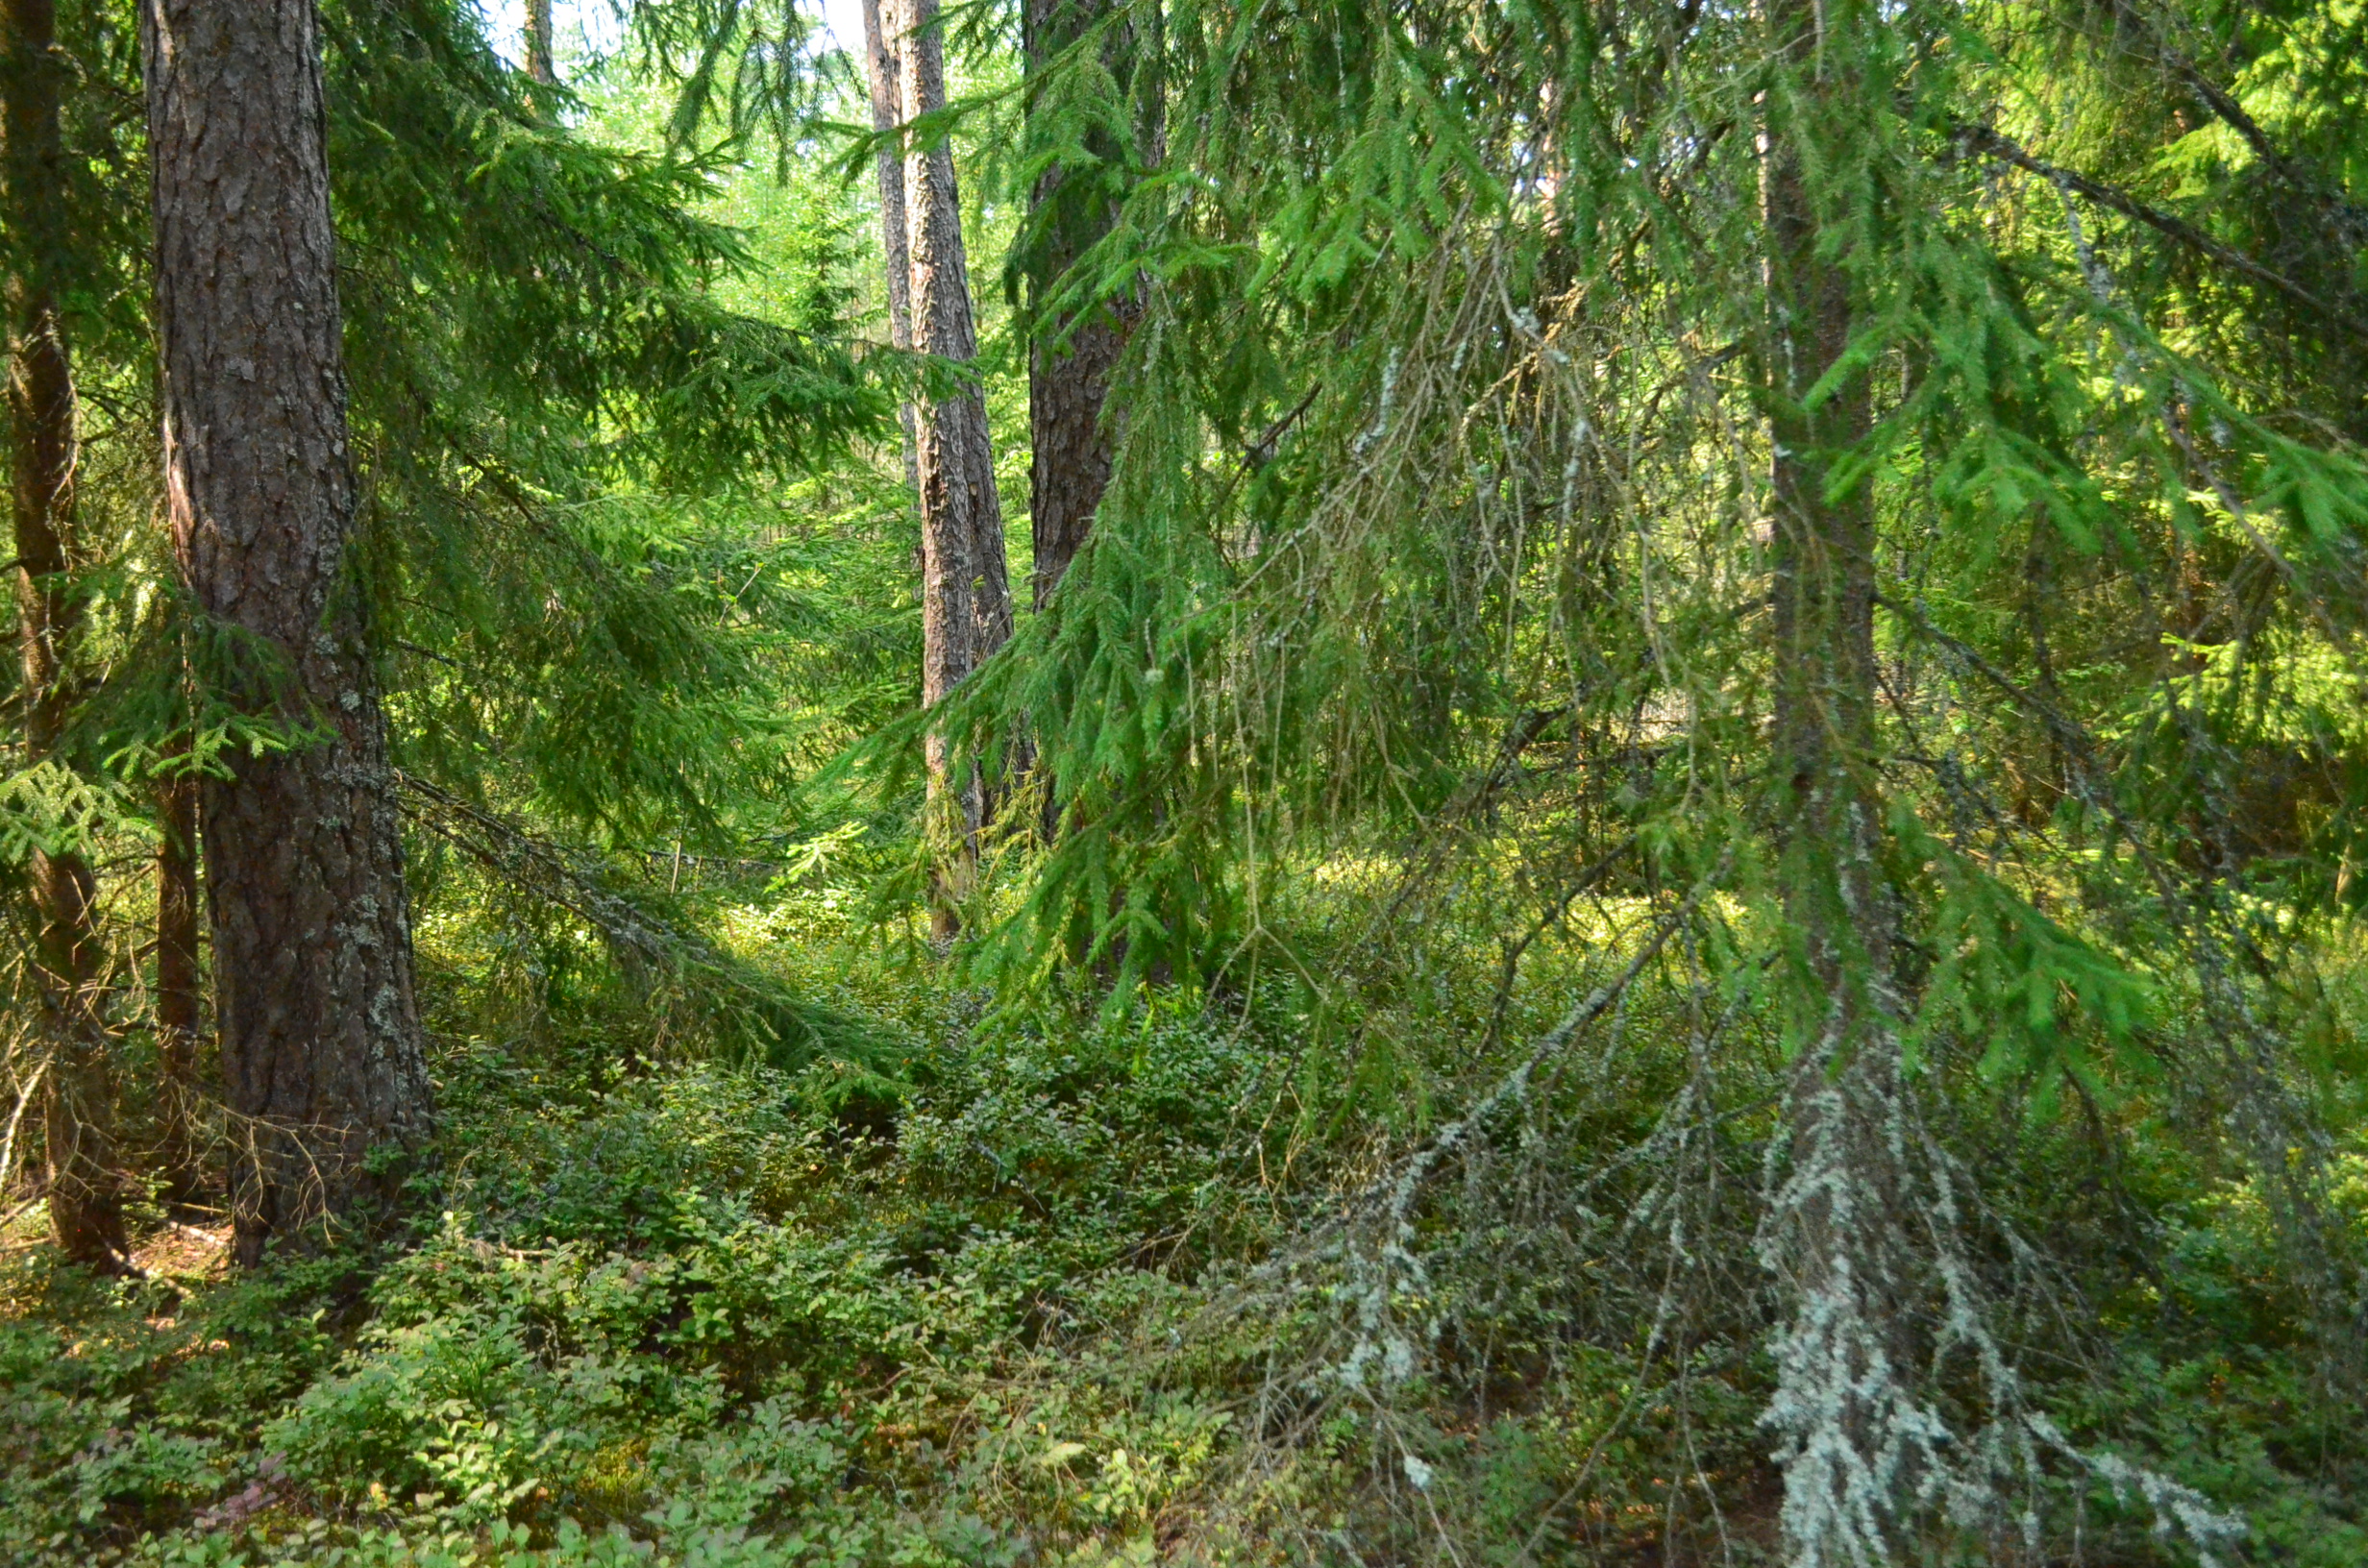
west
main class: Woodland
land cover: Other coniferous woodland
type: hemiboreal forest and nemoral coniferous forest and mixed broadleaved-coniferous forest
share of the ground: 50 - 75 %
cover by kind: coniferous forest trees 70 %, shrubs 15 %, herbaceous plants 10 %, broadleaved forest trees 5 %
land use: Forestry
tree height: > 5 m
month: August
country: LV
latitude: 57.5880
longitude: 22.0049
